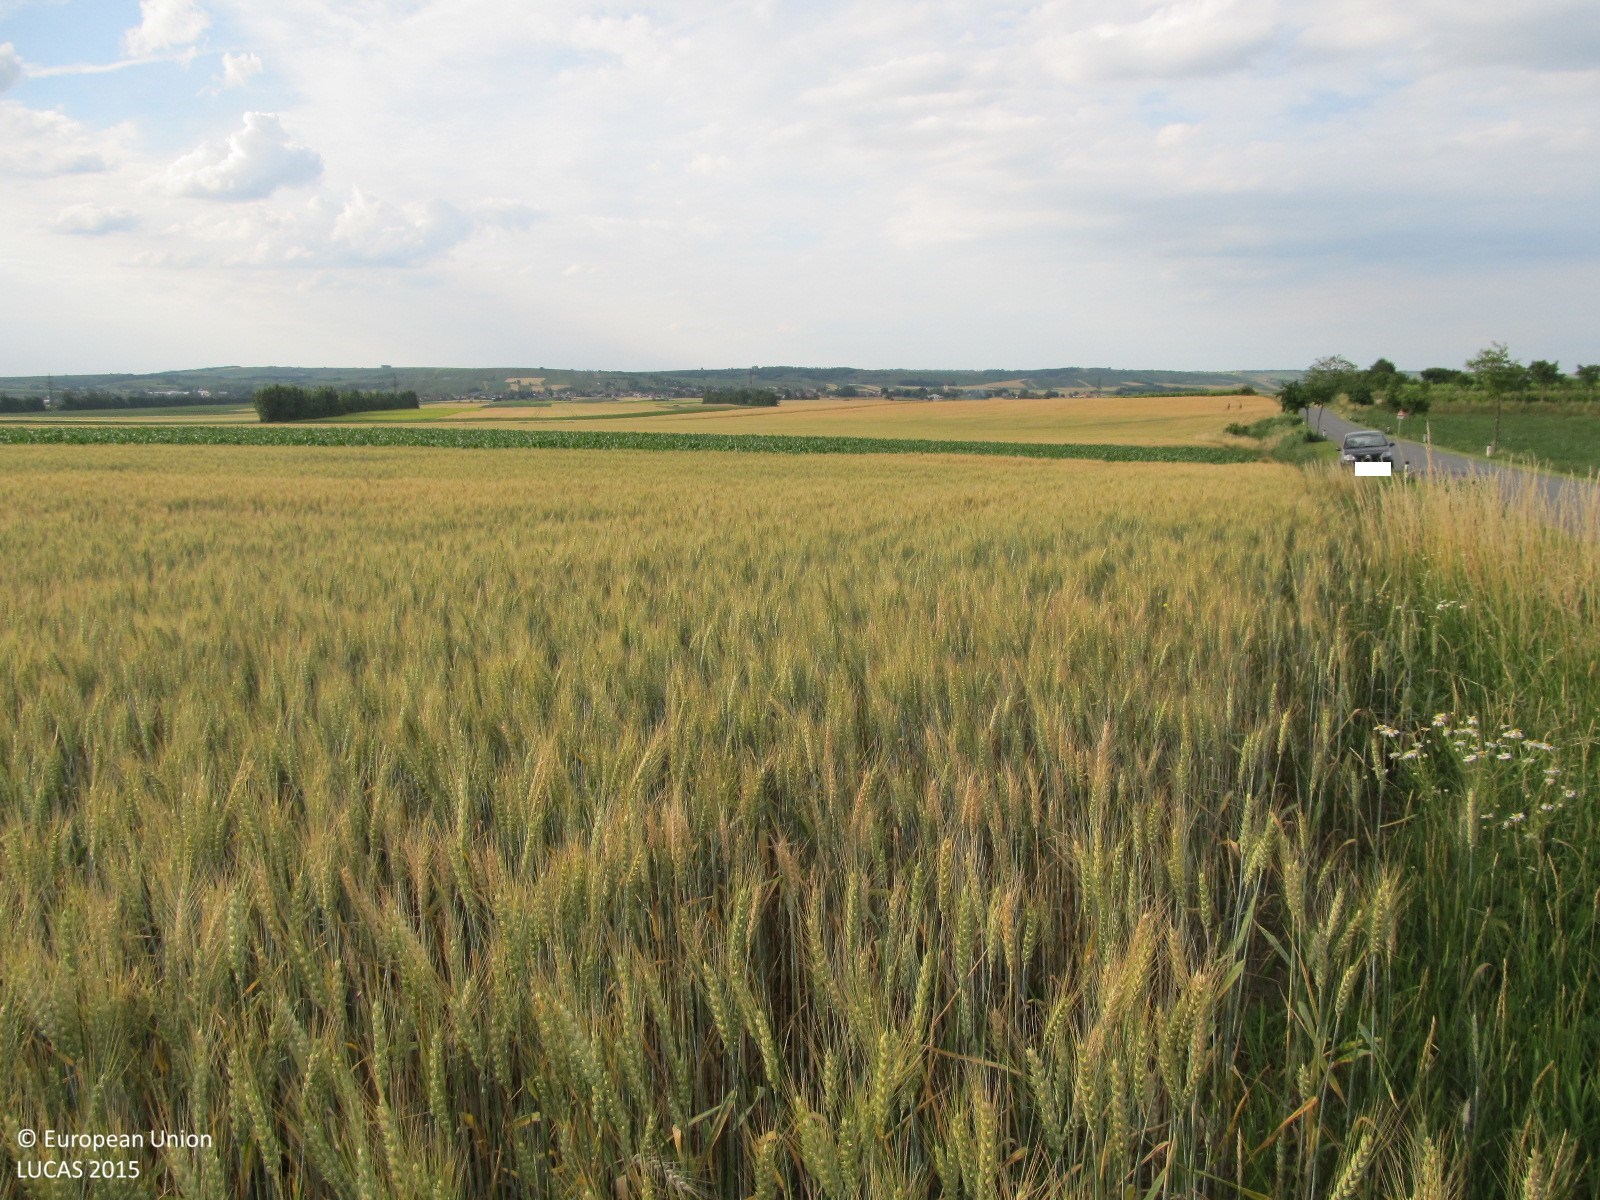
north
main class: Cropland
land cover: Common wheat
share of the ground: > 75 %
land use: Agriculture (excluding fallow land and kitchen gardens)
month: June
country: AT
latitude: 48.6844
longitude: 16.1309
